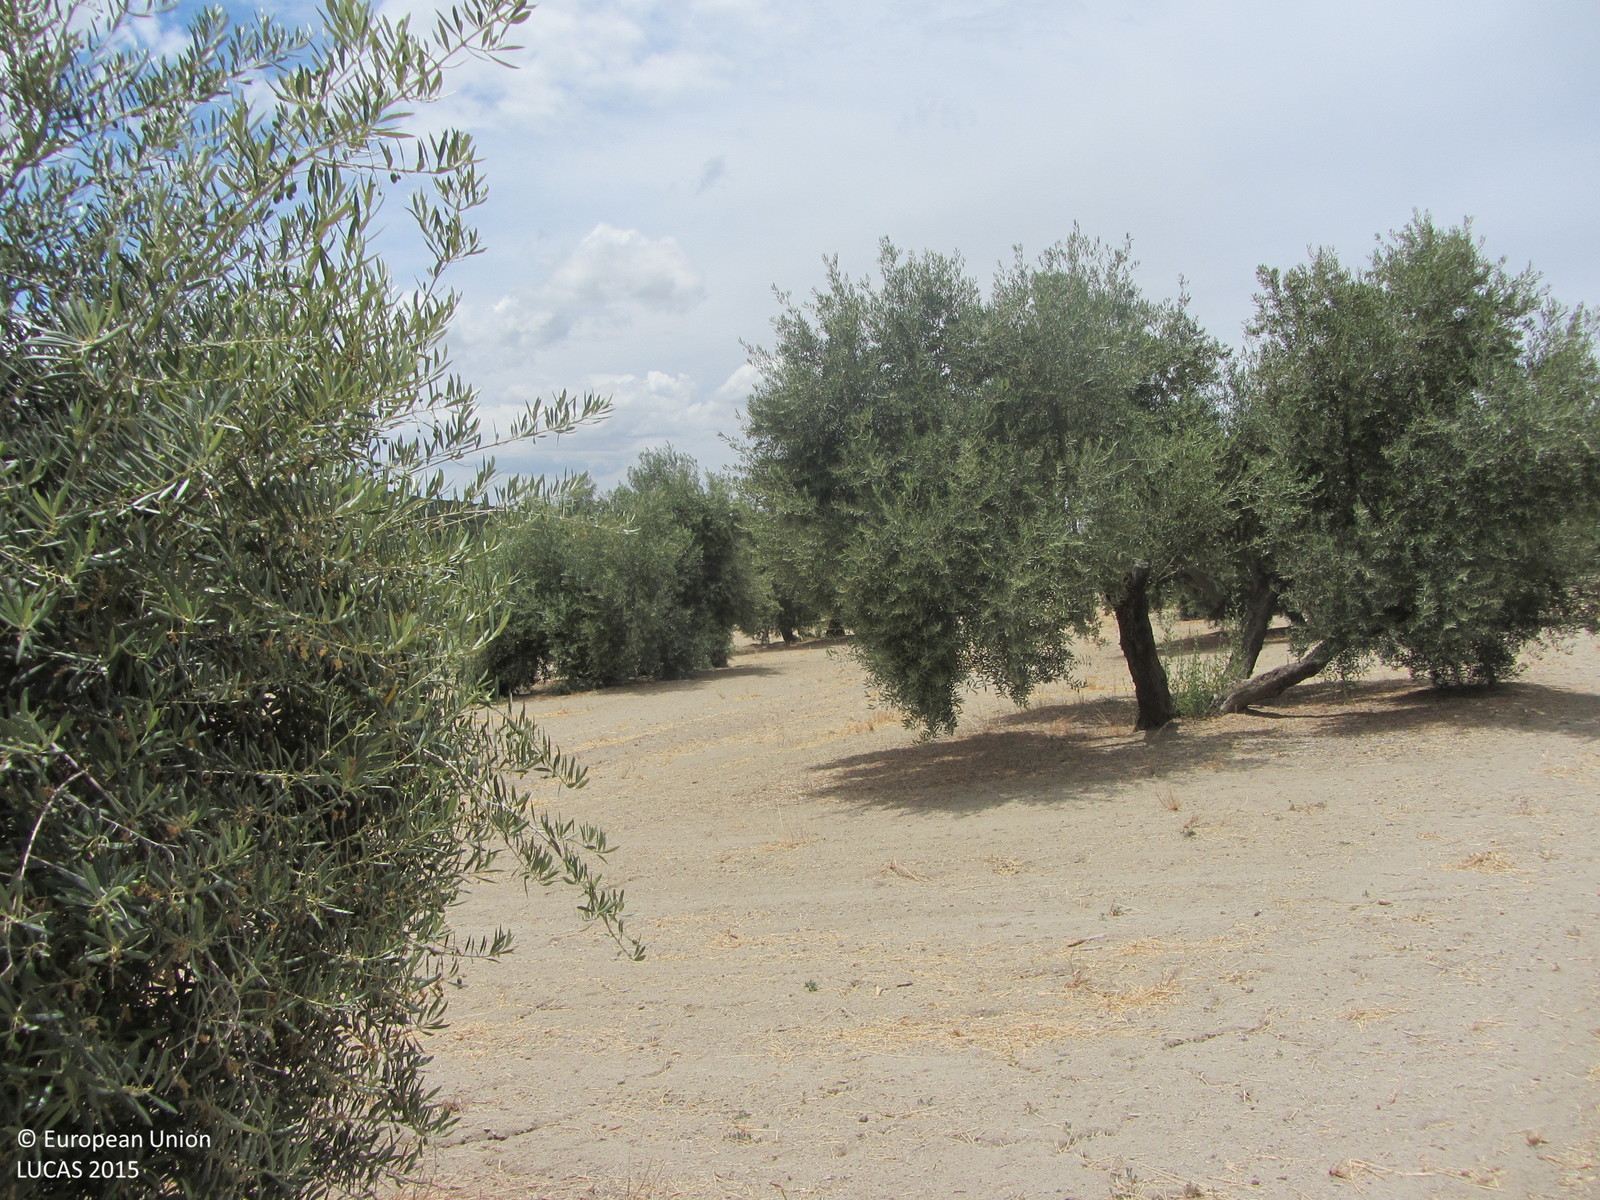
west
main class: Cropland
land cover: Olive groves
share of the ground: 25 - 50 %
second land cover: Other bare soil
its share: > 75 %
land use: Agriculture (excluding fallow land and kitchen gardens)
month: June
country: ES
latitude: 38.0826
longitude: -3.3742
